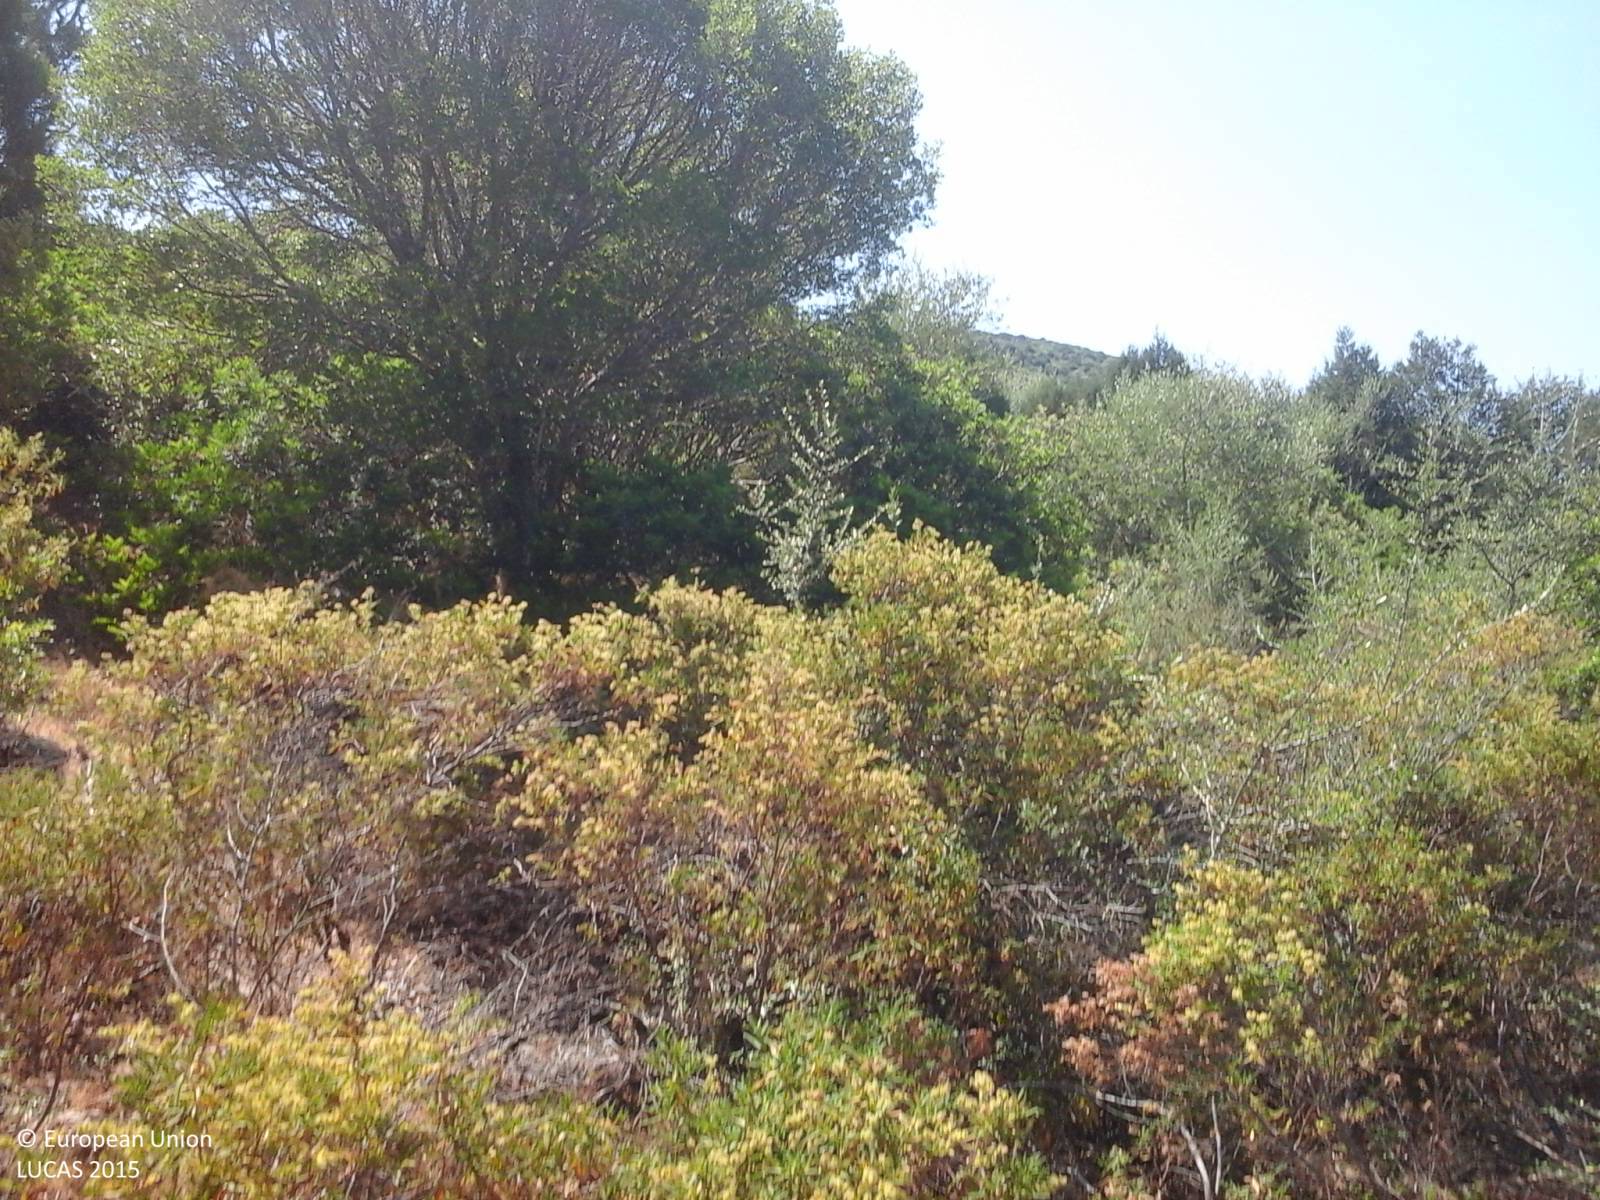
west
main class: Shrubland
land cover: Shrubland with sparse tree cover
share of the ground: 25 - 50 %
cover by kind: shrubs 70 %, herbaceous plants 25 %, broadleaved forest trees 5 %
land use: Agriculture (excluding fallow land and kitchen gardens)
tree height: > 5 m
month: June
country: IT
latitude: 38.9201
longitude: 8.8655
